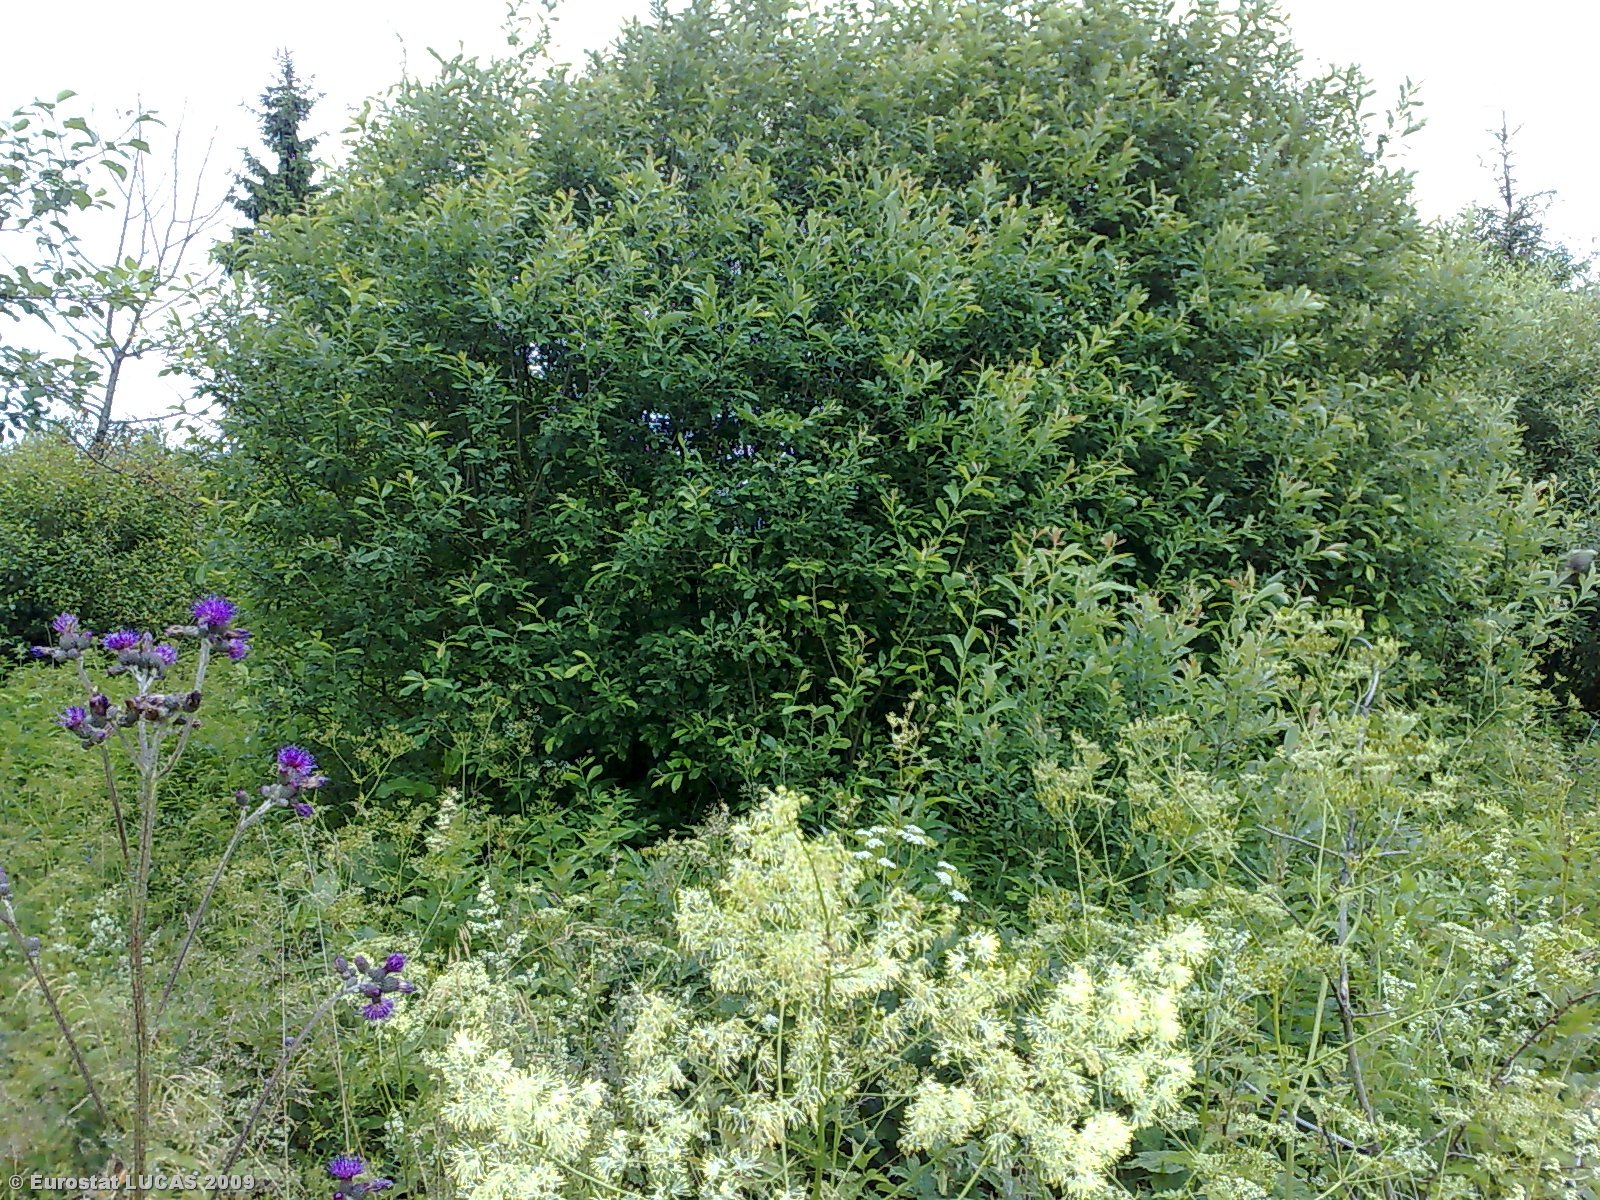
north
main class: Grassland
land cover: Grassland with sparse tree/shrub cover
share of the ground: > 75 %
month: July
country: LT
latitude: 55.5939
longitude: 22.8407
